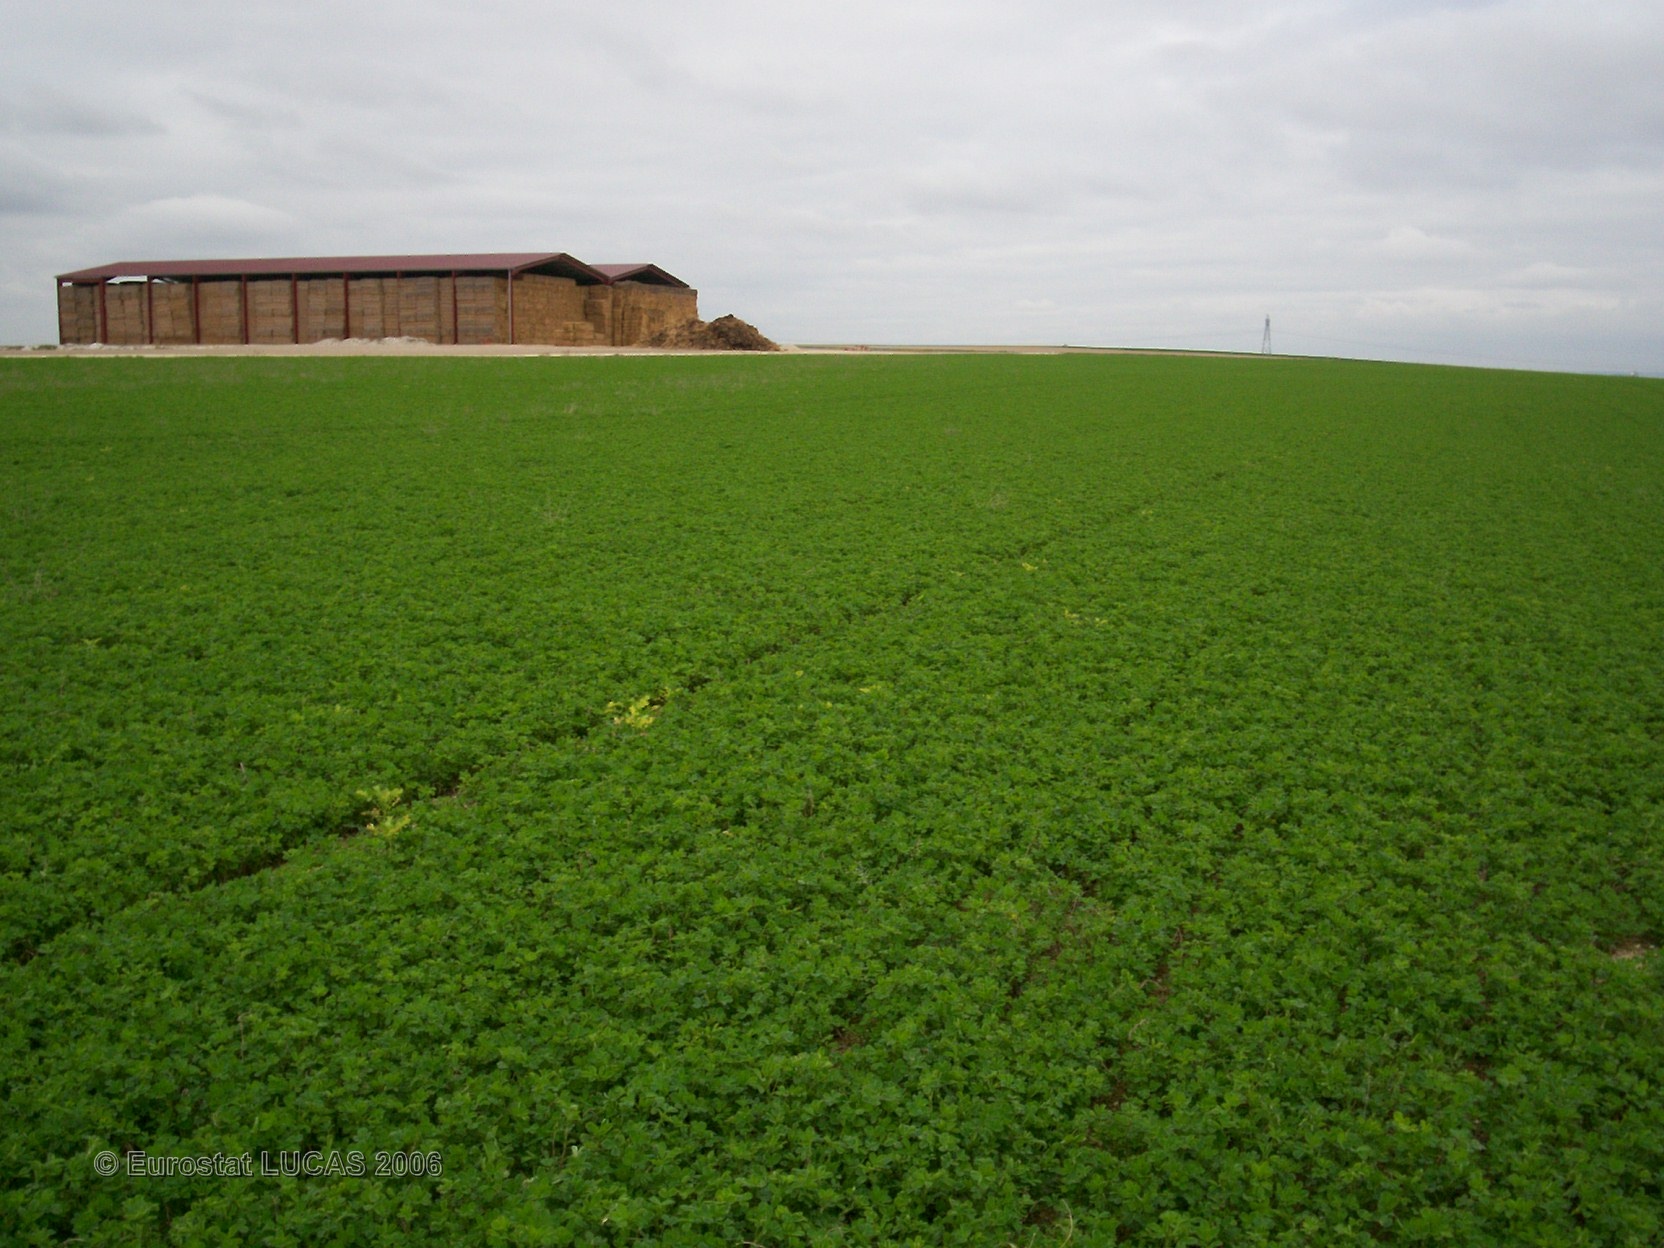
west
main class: Cropland
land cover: Lucerne
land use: Agriculture (excluding fallow land and kitchen gardens)
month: April
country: FR
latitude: 48.5440
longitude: 3.9407
